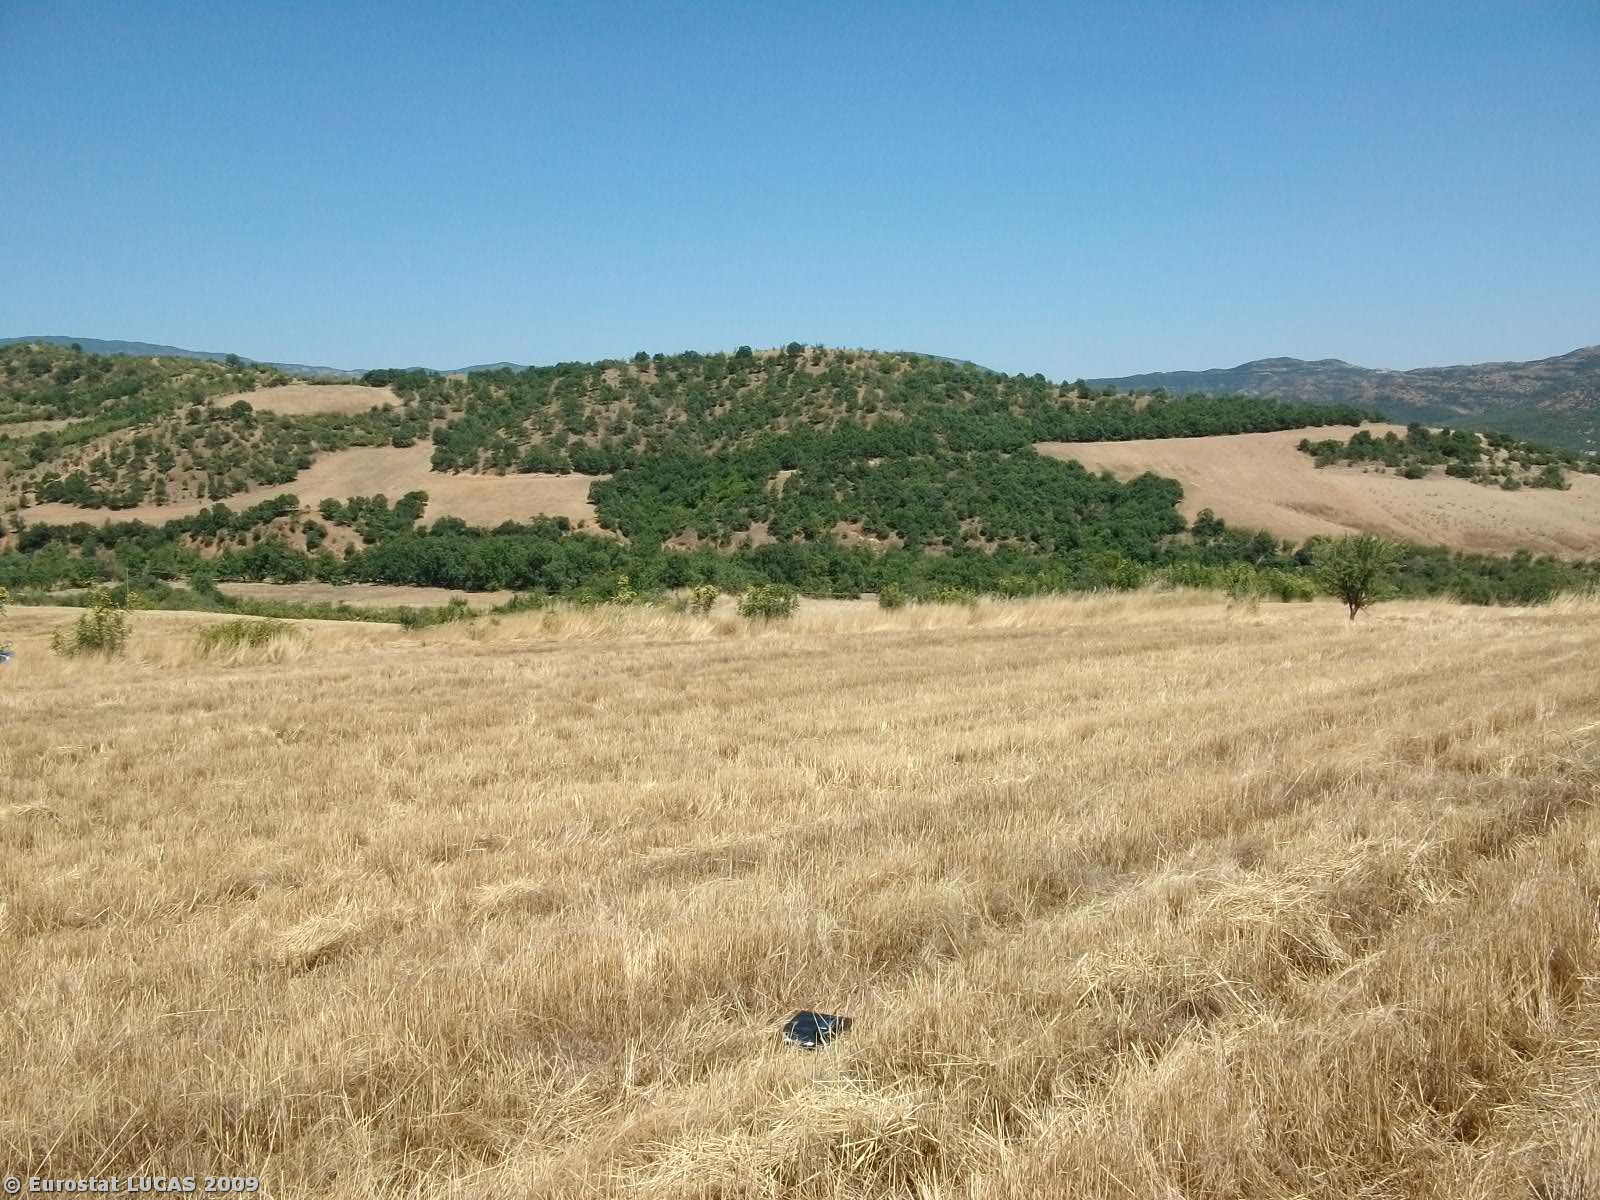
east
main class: Cropland
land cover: Durum wheat
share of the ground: < 10 %
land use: Agriculture (excluding fallow land and kitchen gardens)
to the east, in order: Durum wheat; Grass margins; Tracks; Grassland without tree/shrub cover; Broadleaved woodland
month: July
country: GR
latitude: 39.7279
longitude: 21.7103
